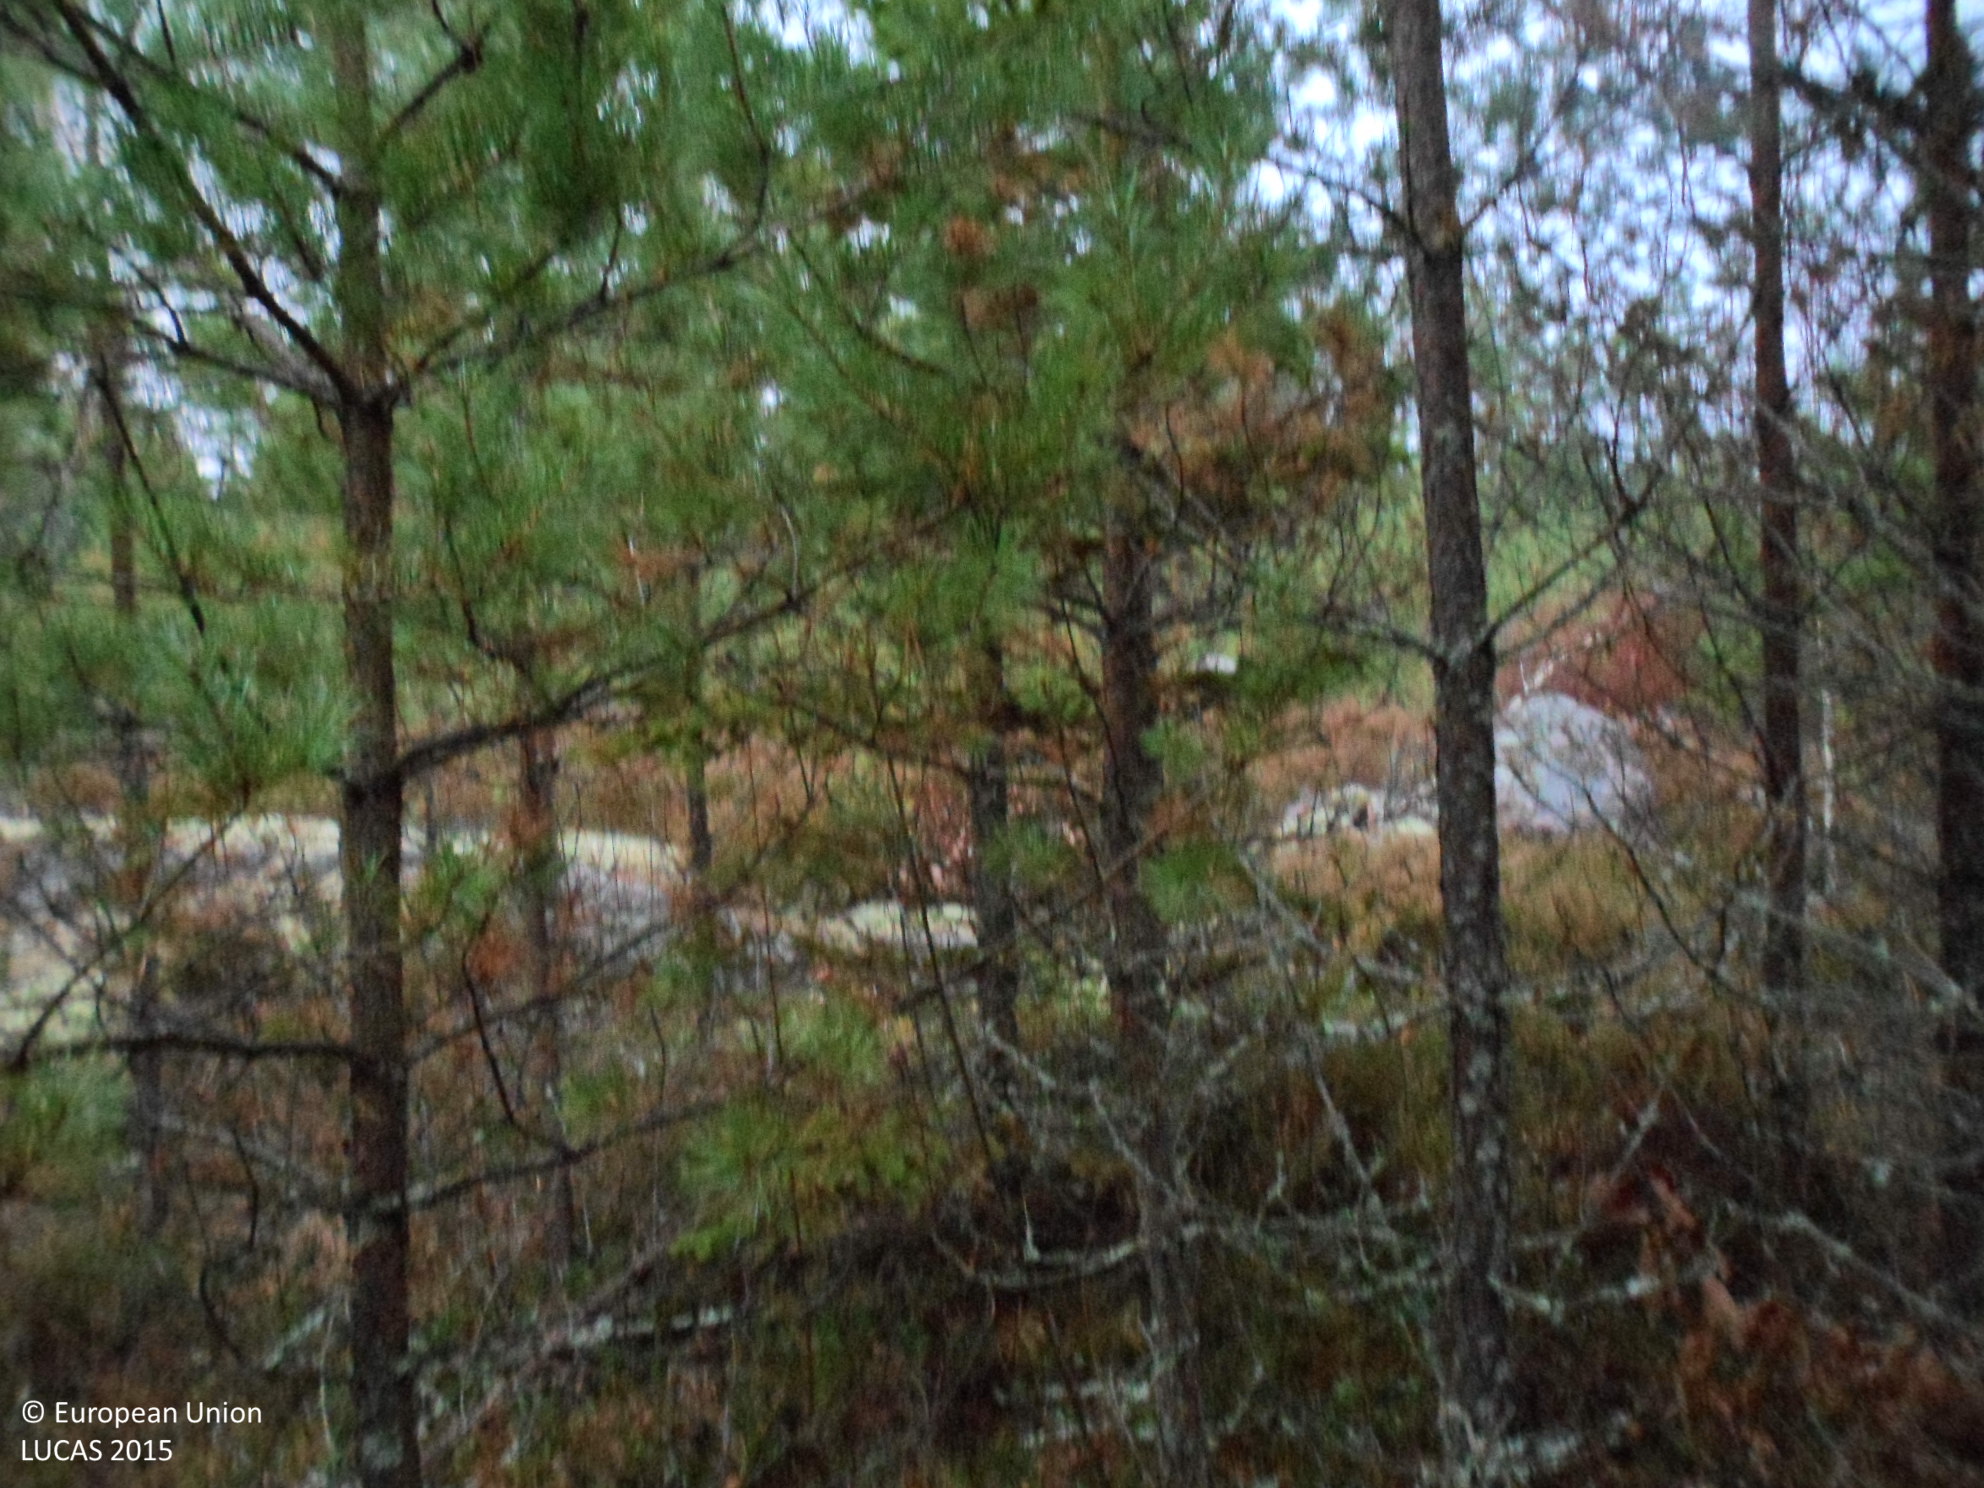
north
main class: Woodland
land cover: Pine dominated coniferous woodland
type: boreal forest
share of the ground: 50 - 75 %
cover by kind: coniferous forest trees 55 %, shrubs 30 %, lichens and mosses 10 %, broadleaved forest trees 5 %
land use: Forestry
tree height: < 5 m
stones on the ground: > 50 %
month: November
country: SE
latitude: 57.0223
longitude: 15.9785
